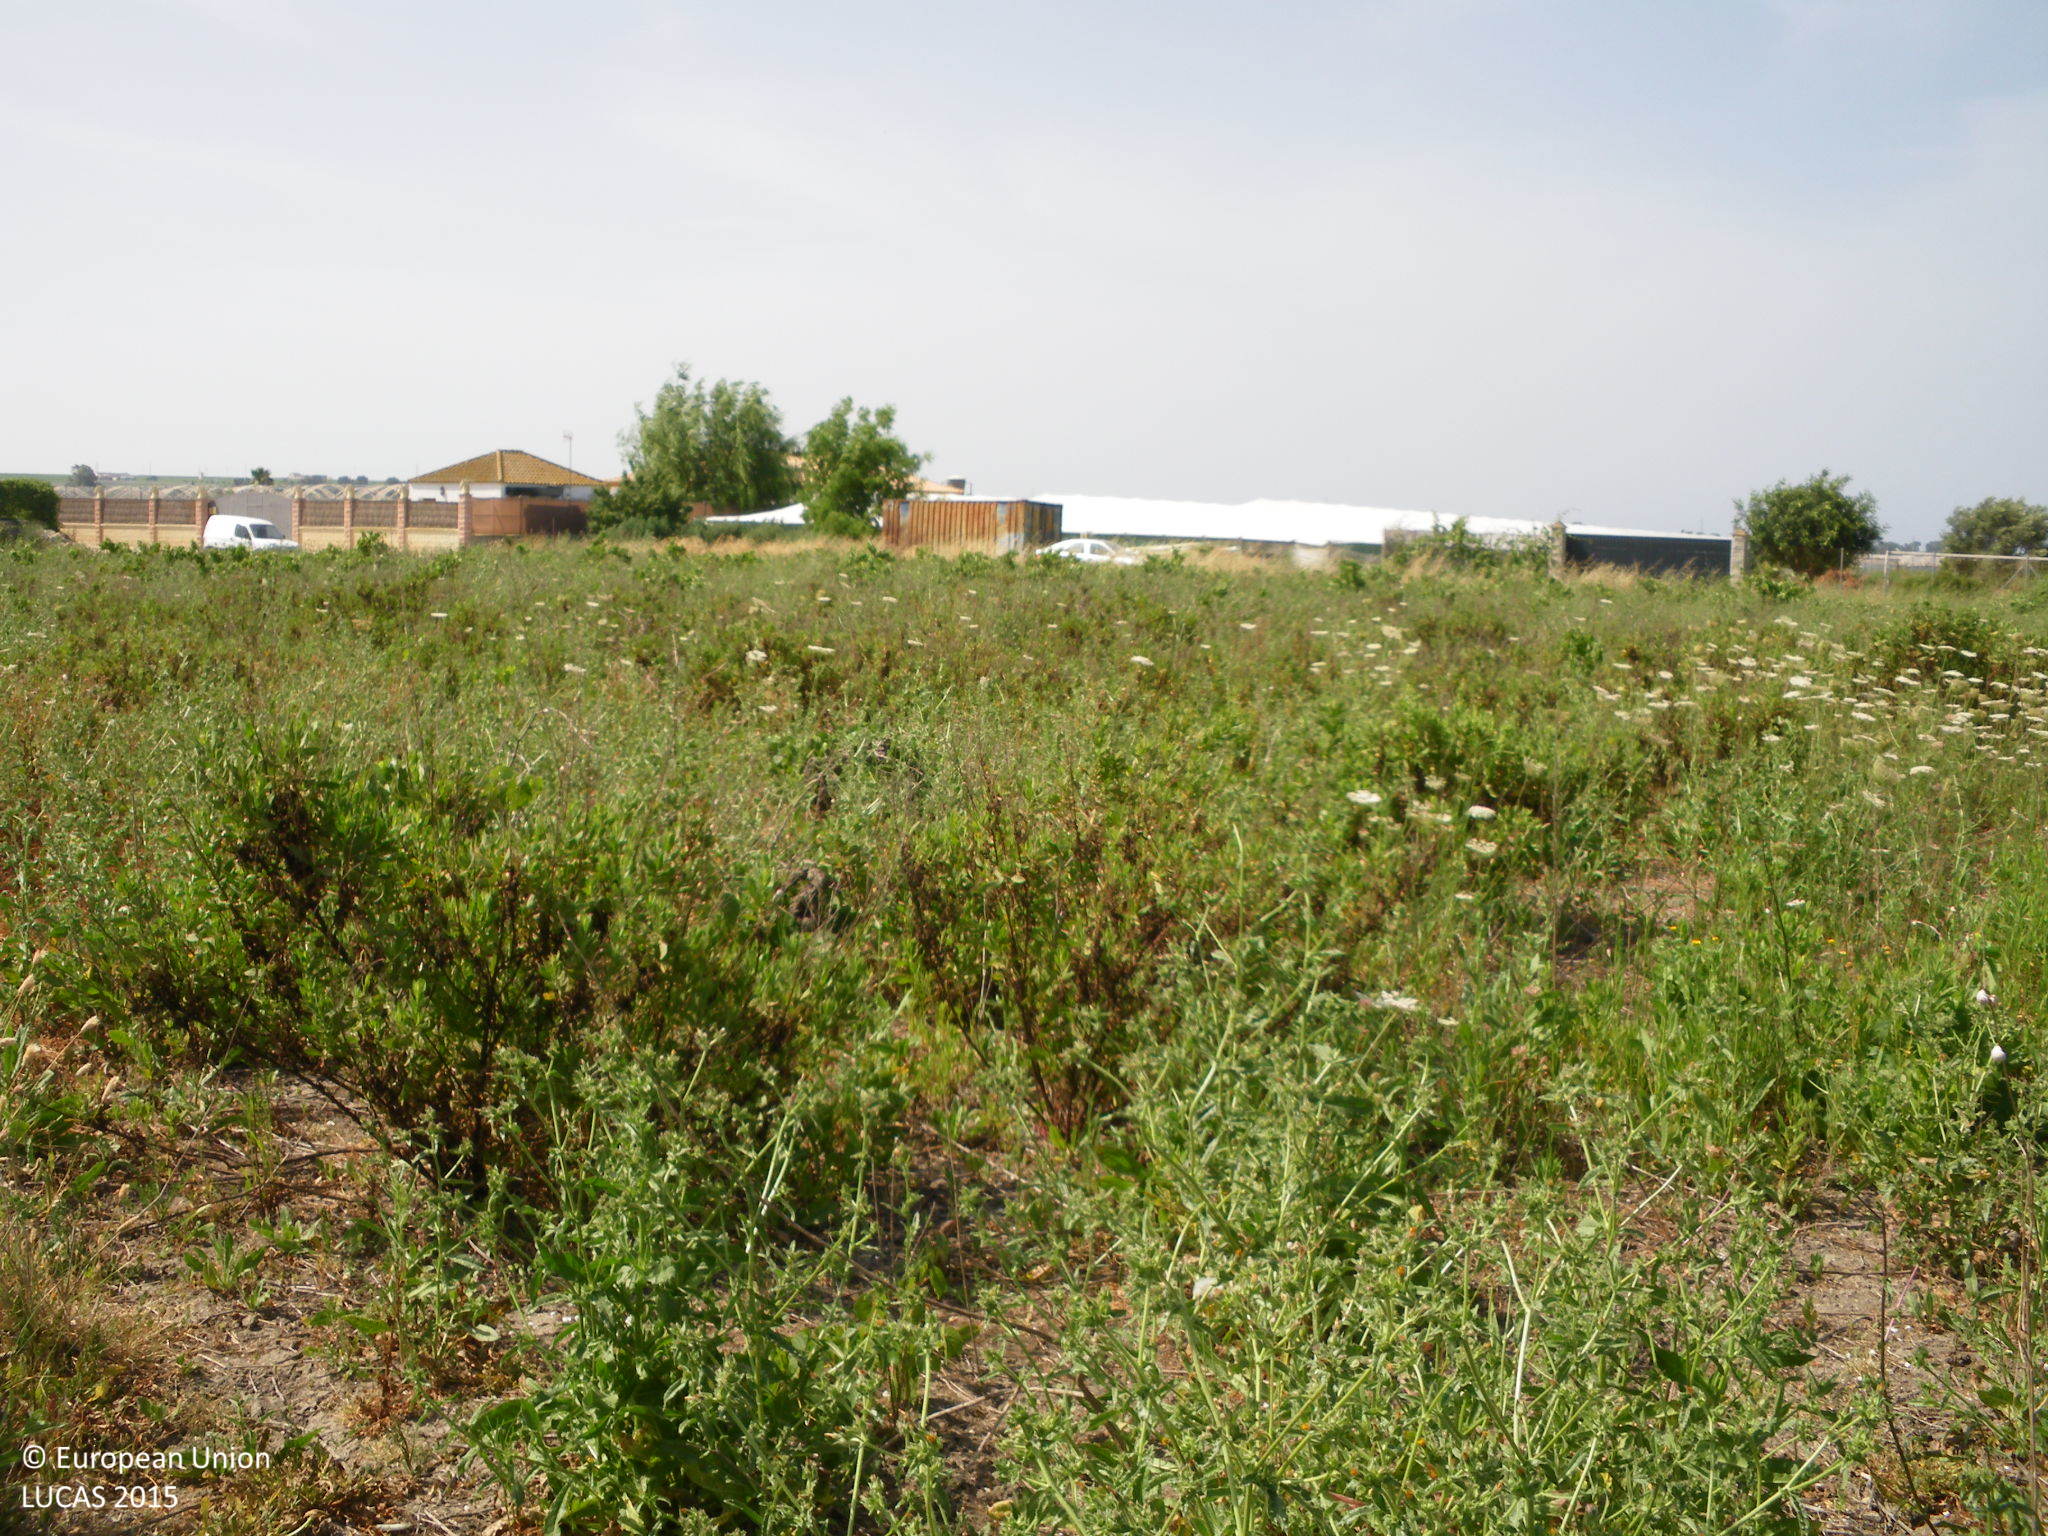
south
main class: Grassland
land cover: Spontaneously vegetated surfaces
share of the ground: > 75 %
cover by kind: herbaceous plants 90 %, shrubs 5 %, unconsolidated bare surface 5 %
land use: Fallow land
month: June
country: ES
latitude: 36.7414
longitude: -6.3794
